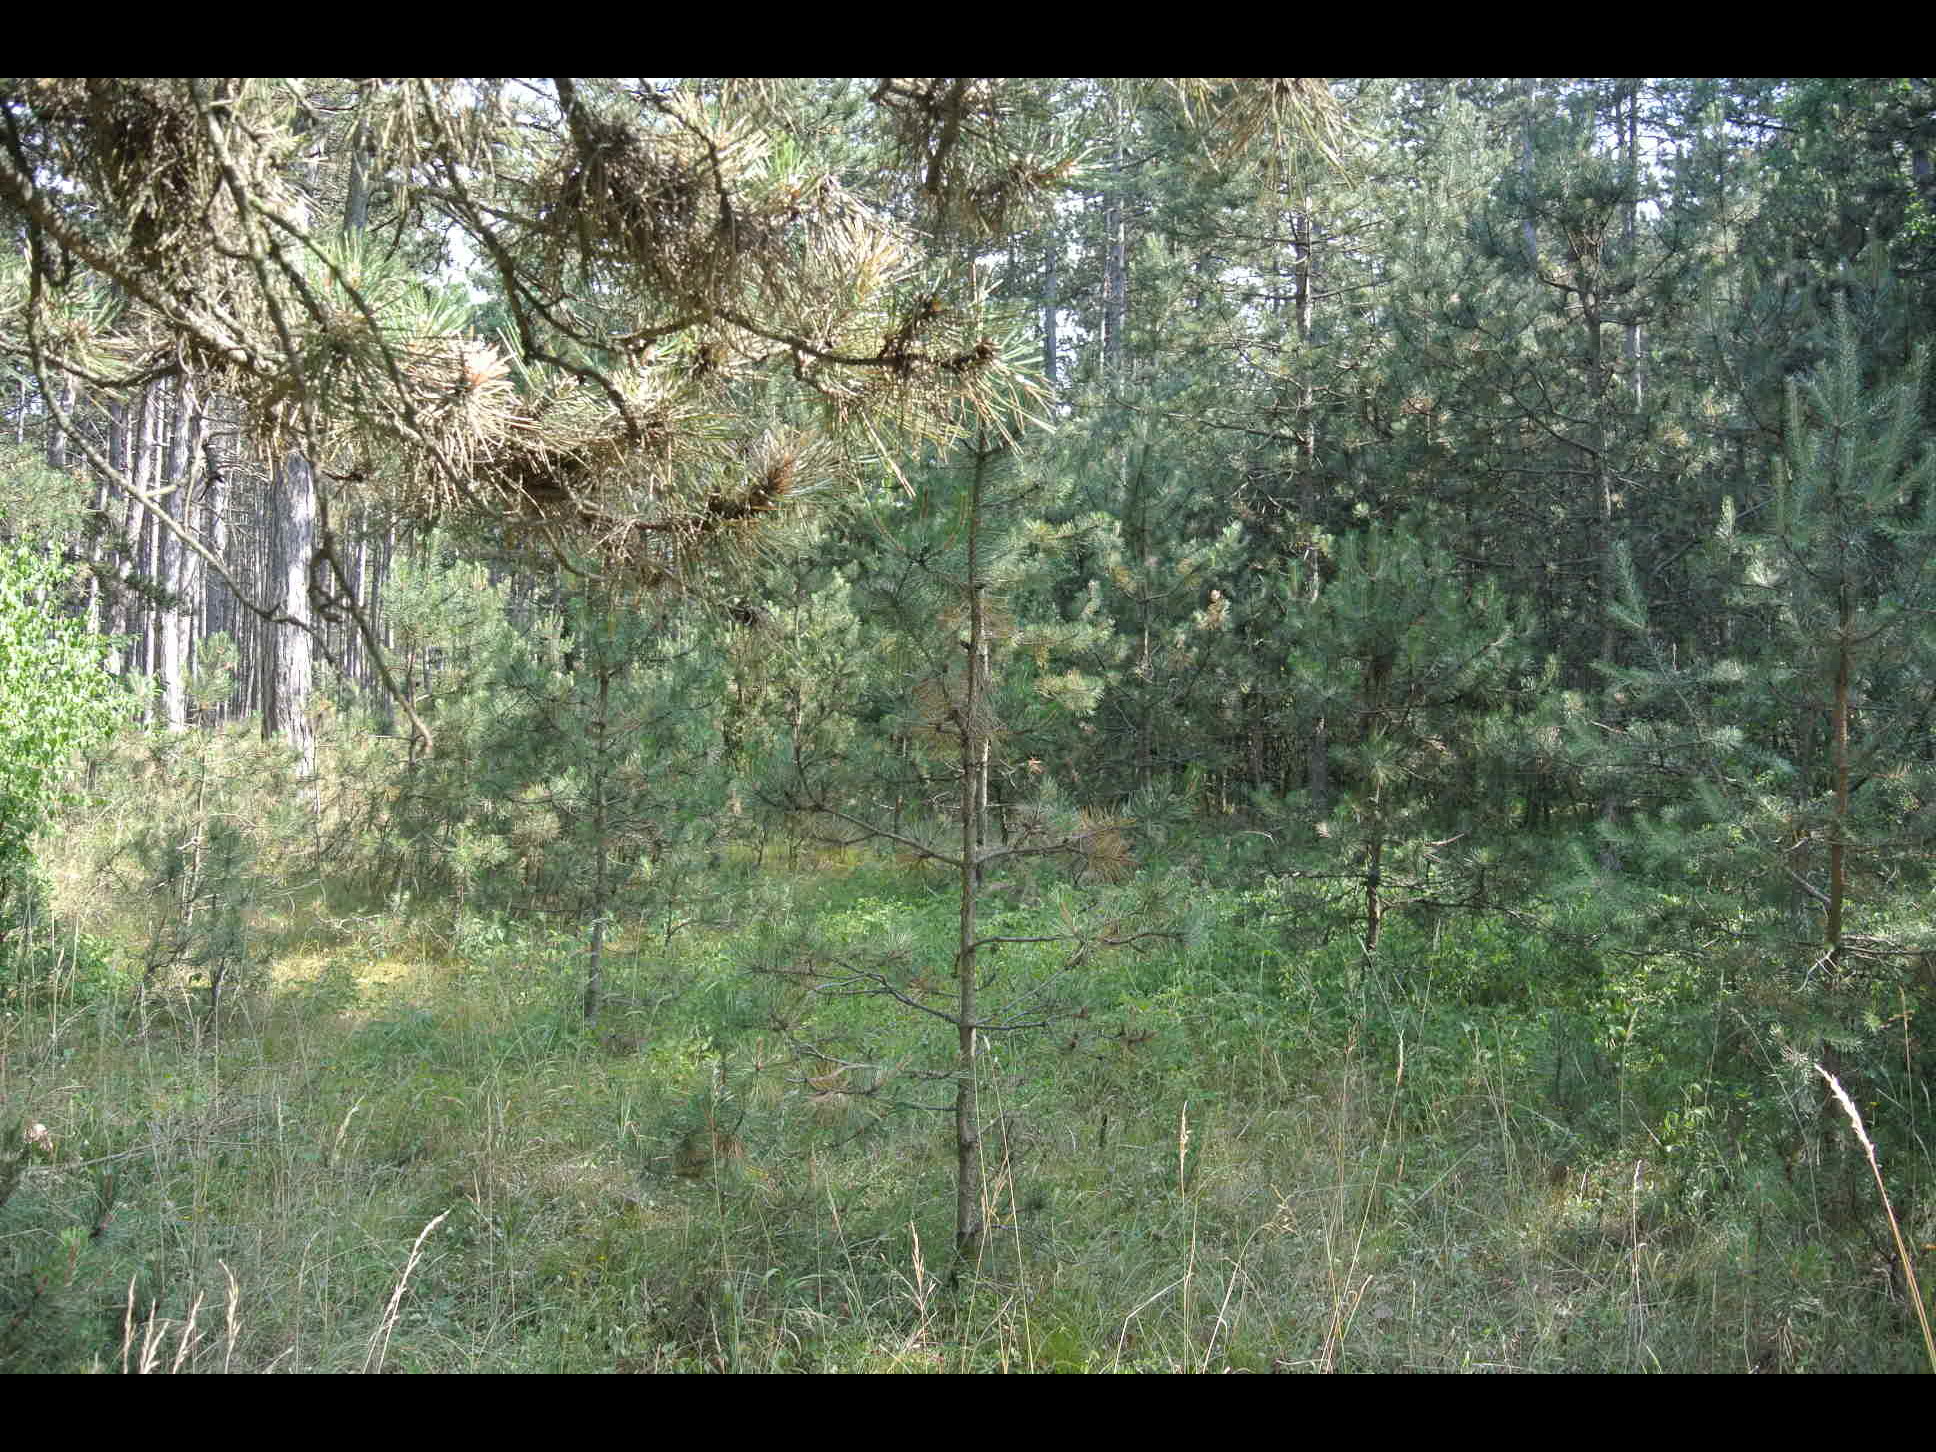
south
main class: Woodland
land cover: Pine dominated coniferous woodland
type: alpine coniferous forest
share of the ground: 25 - 50 %
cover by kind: coniferous forest trees 90 %, herbaceous plants 10 %
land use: Forestry
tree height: > 5 m
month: July
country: AT
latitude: 47.7629
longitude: 16.1538
